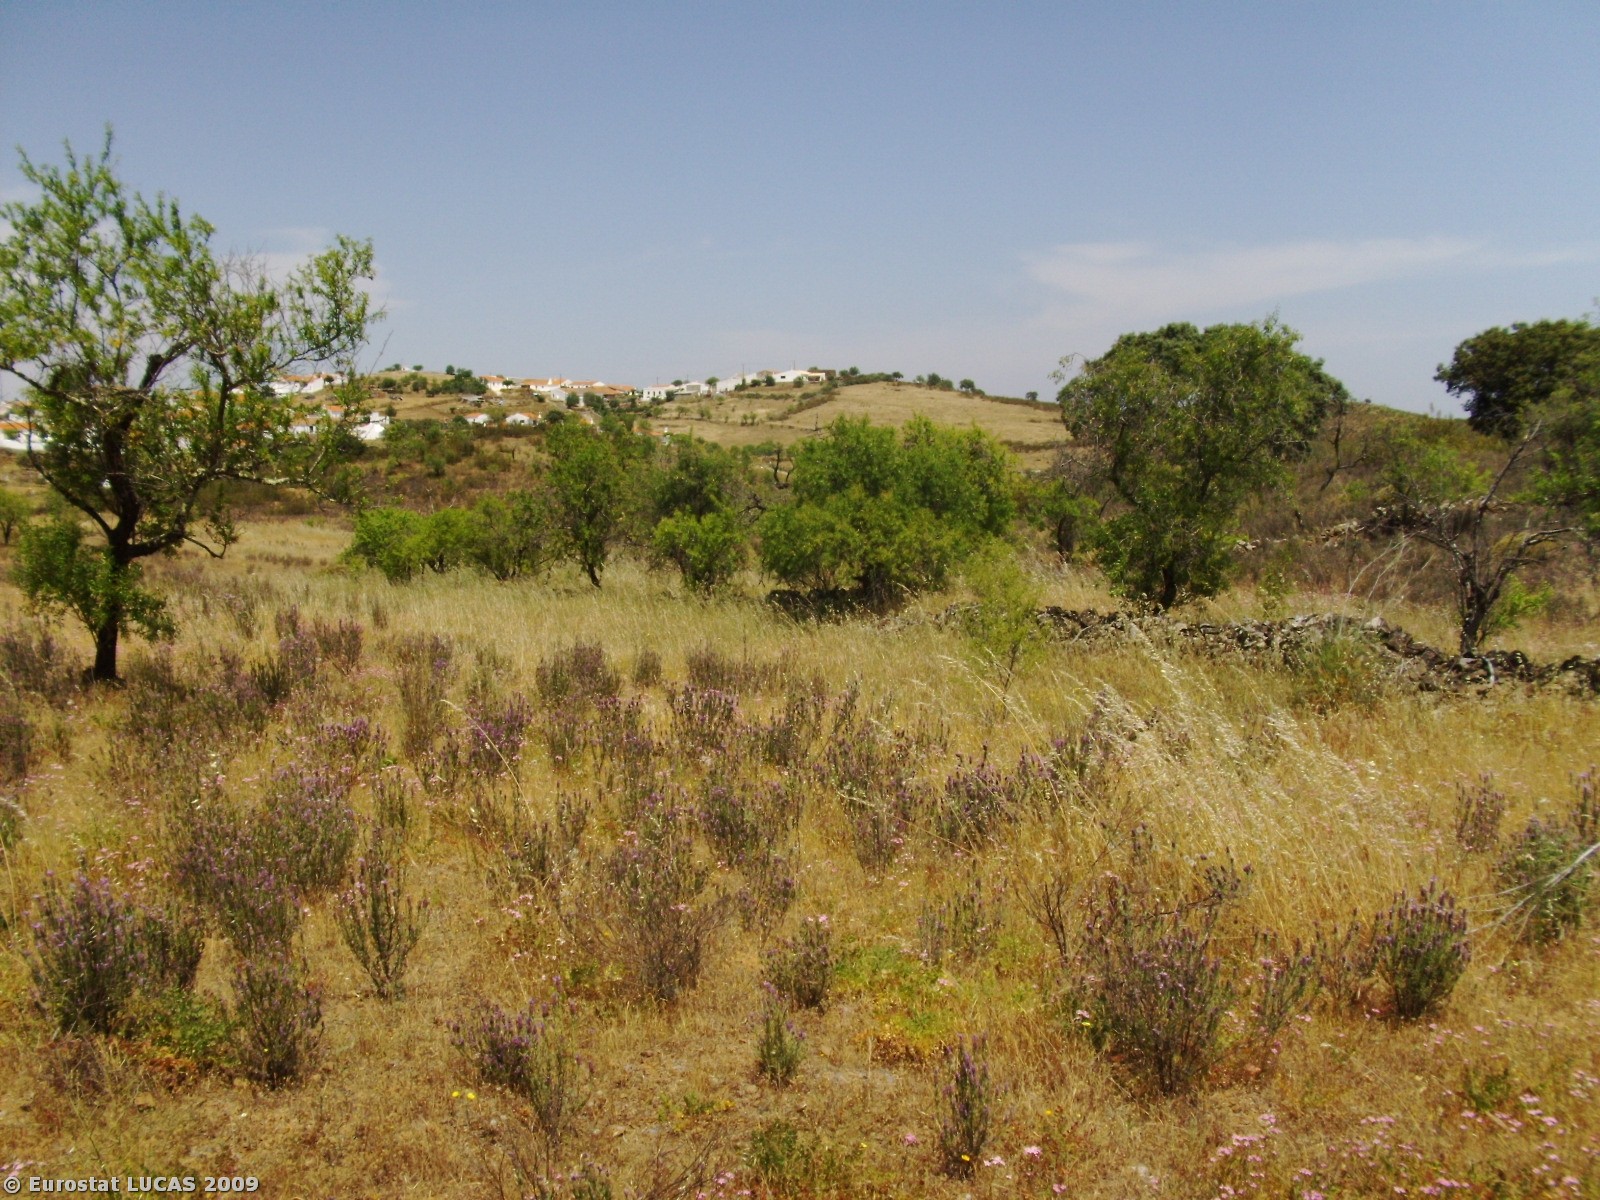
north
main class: Cropland
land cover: Nuts trees
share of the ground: < 10 %
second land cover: Spontaneously vegetated surfaces
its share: > 75 %
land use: Agriculture (excluding fallow land and kitchen gardens)
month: May
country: PT
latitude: 37.4200
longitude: -7.7186
